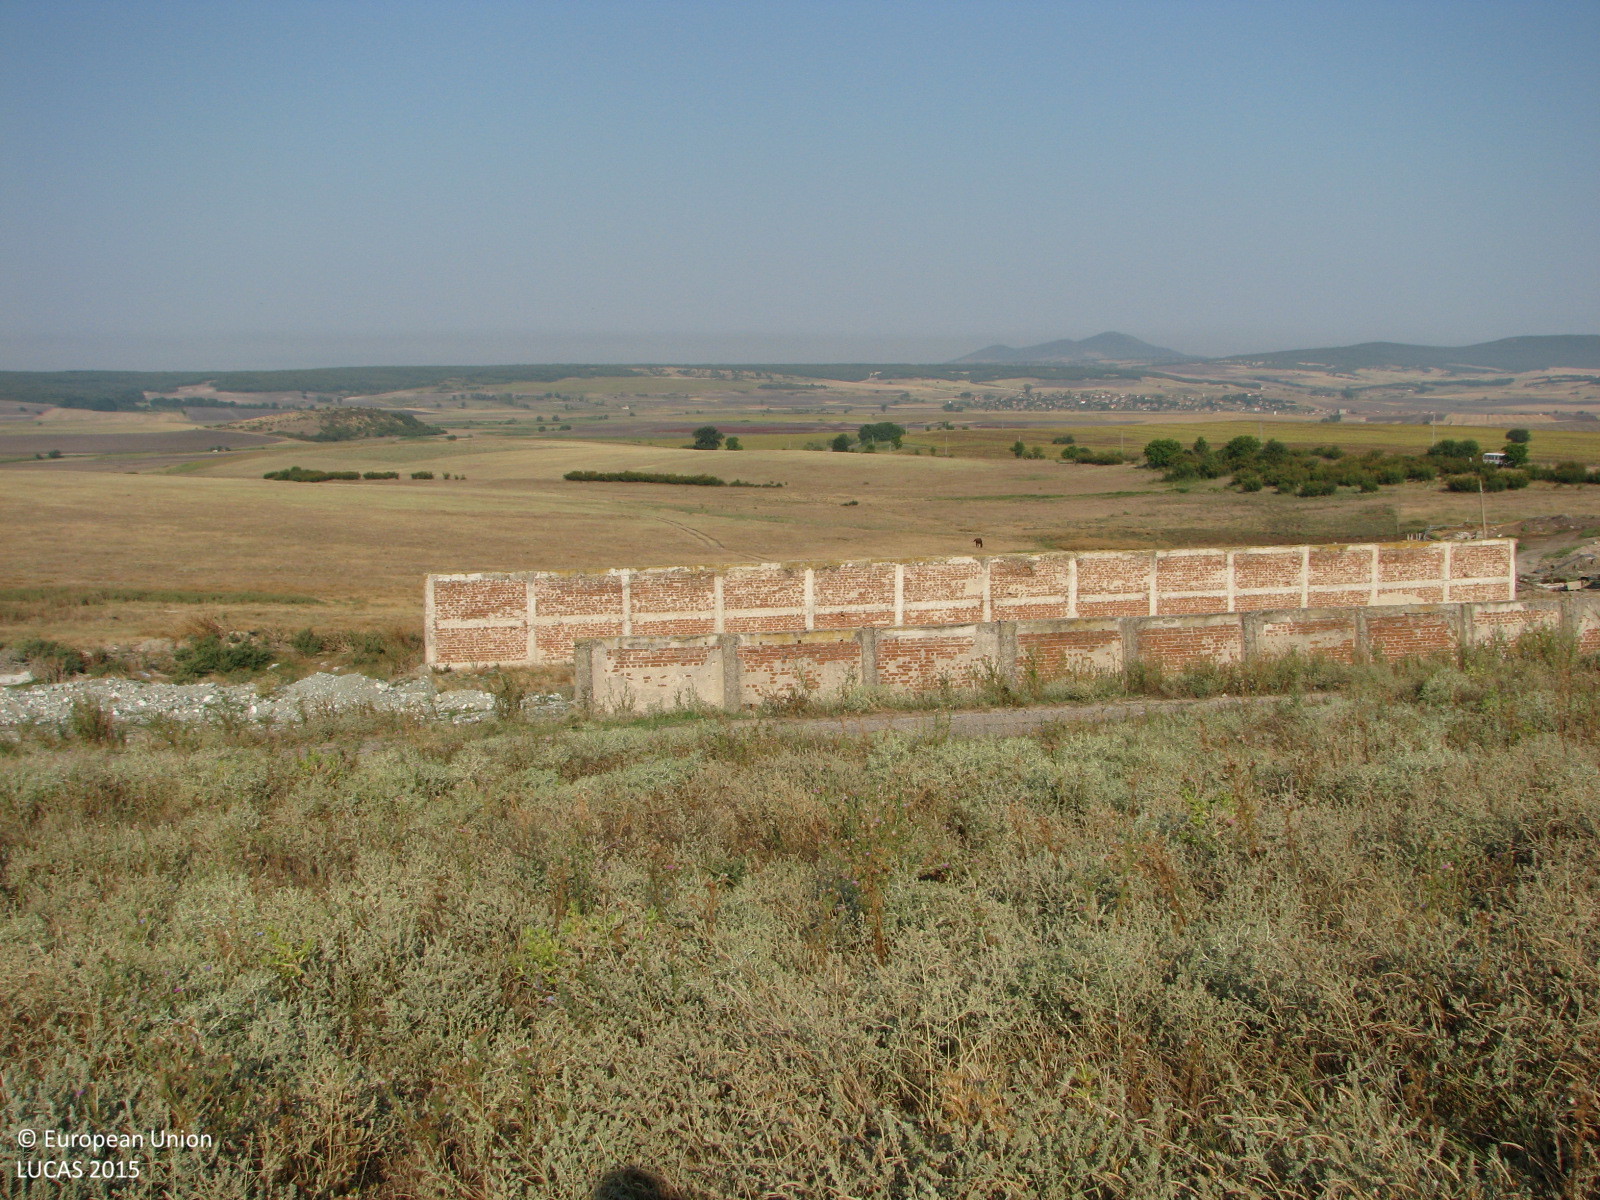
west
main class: Grassland
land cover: Spontaneously vegetated surfaces
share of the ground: > 75 %
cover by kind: herbaceous plants 100 %
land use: Agriculture (excluding fallow land and kitchen gardens)
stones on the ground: < 10 %
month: August
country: BG
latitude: 42.1703
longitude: 26.5150
